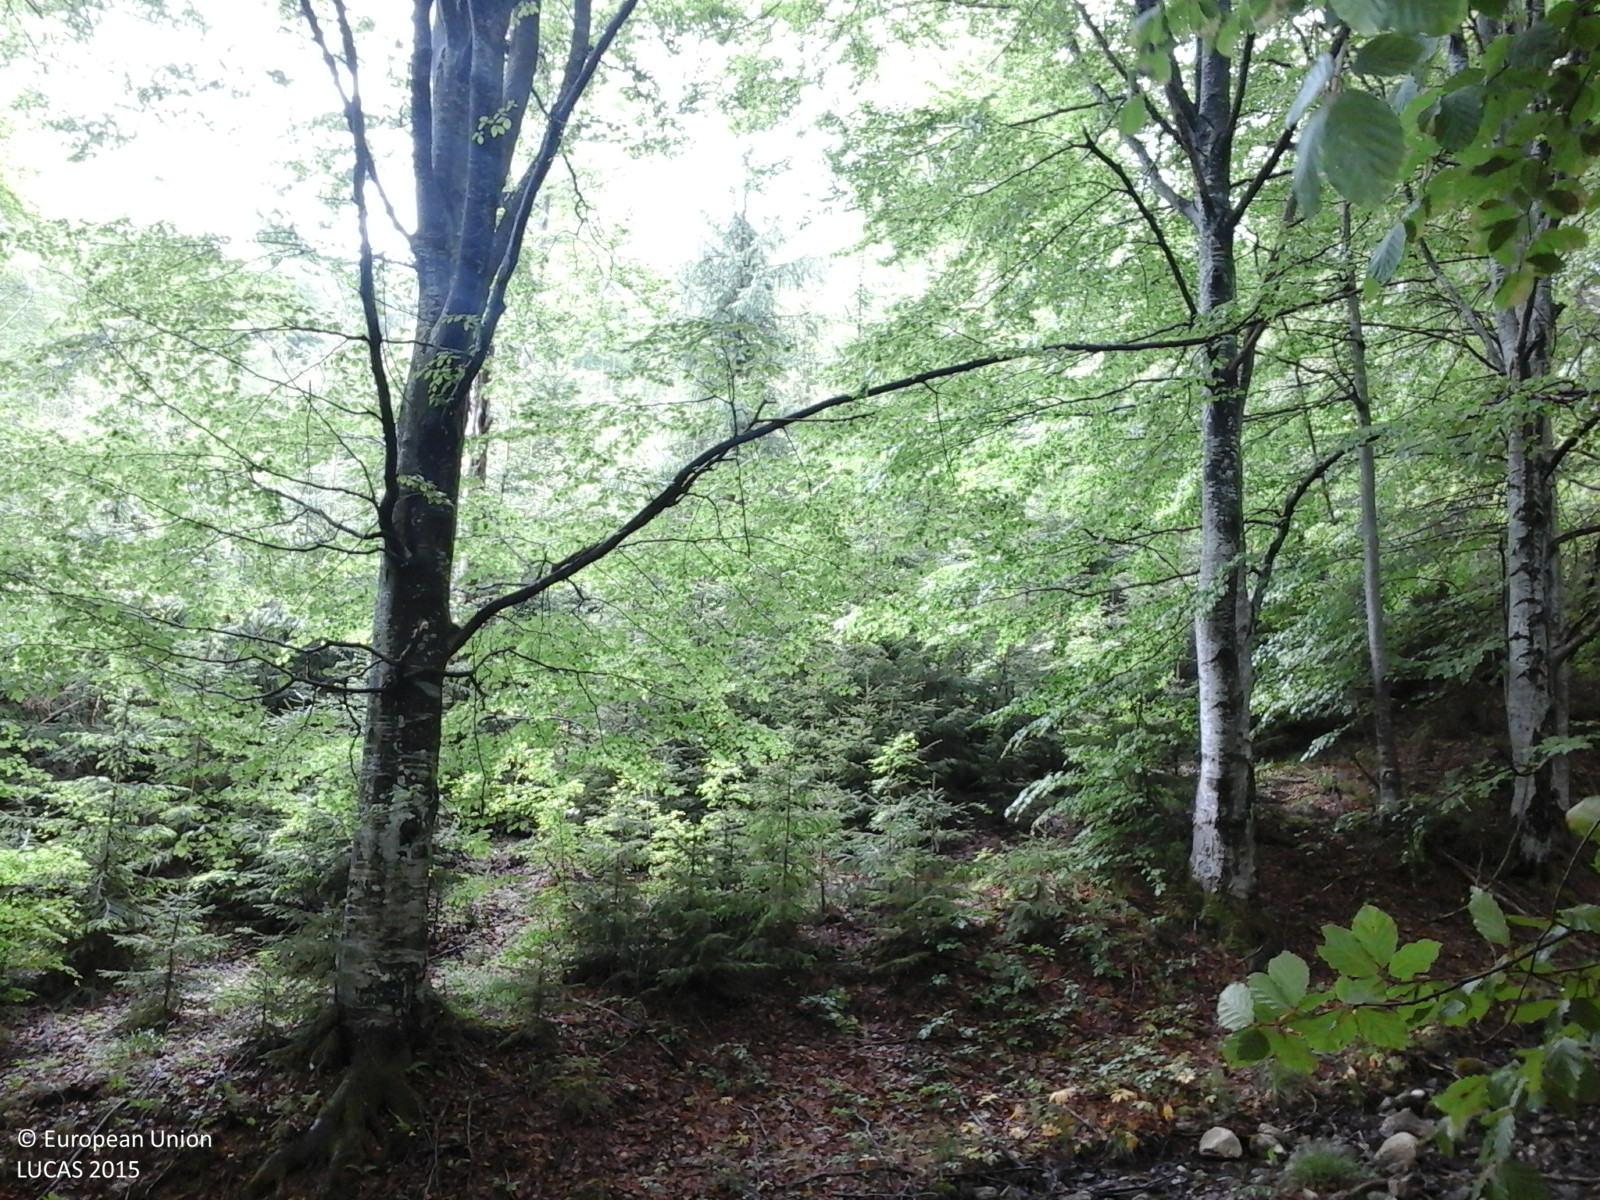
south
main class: Woodland
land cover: Other mixed woodland
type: mountainous beech forest
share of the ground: > 75 %
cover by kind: broadleaved forest trees 60 %, coniferous forest trees 40 %
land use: Forestry
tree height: > 5 m
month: May
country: RO
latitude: 45.5006
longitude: 26.0210
